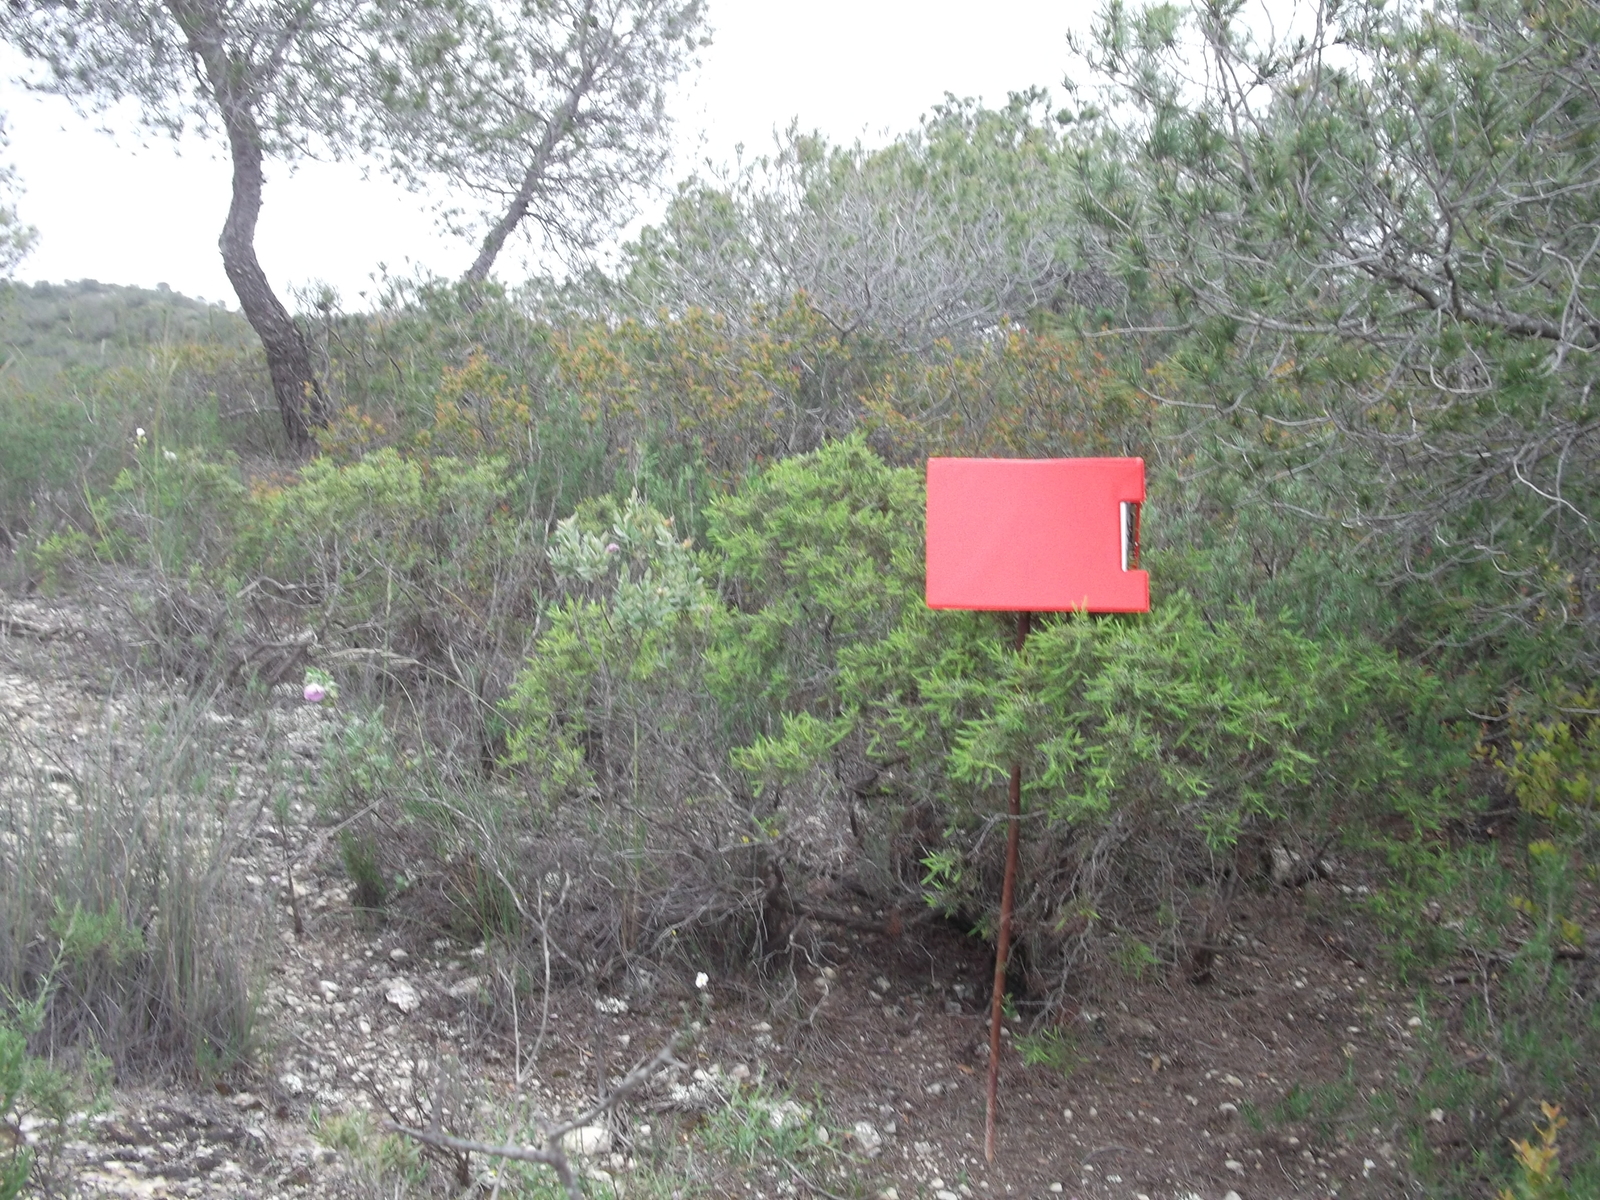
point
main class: Woodland
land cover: Pine dominated coniferous woodland
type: coniferous forest of the mediterranean region
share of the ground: 25 - 50 %
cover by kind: shrubs 65 %, coniferous forest trees 35 %
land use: Semi-natural and natural areas not in use
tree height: > 5 m
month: April
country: ES
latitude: 38.0776
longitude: -1.6040
